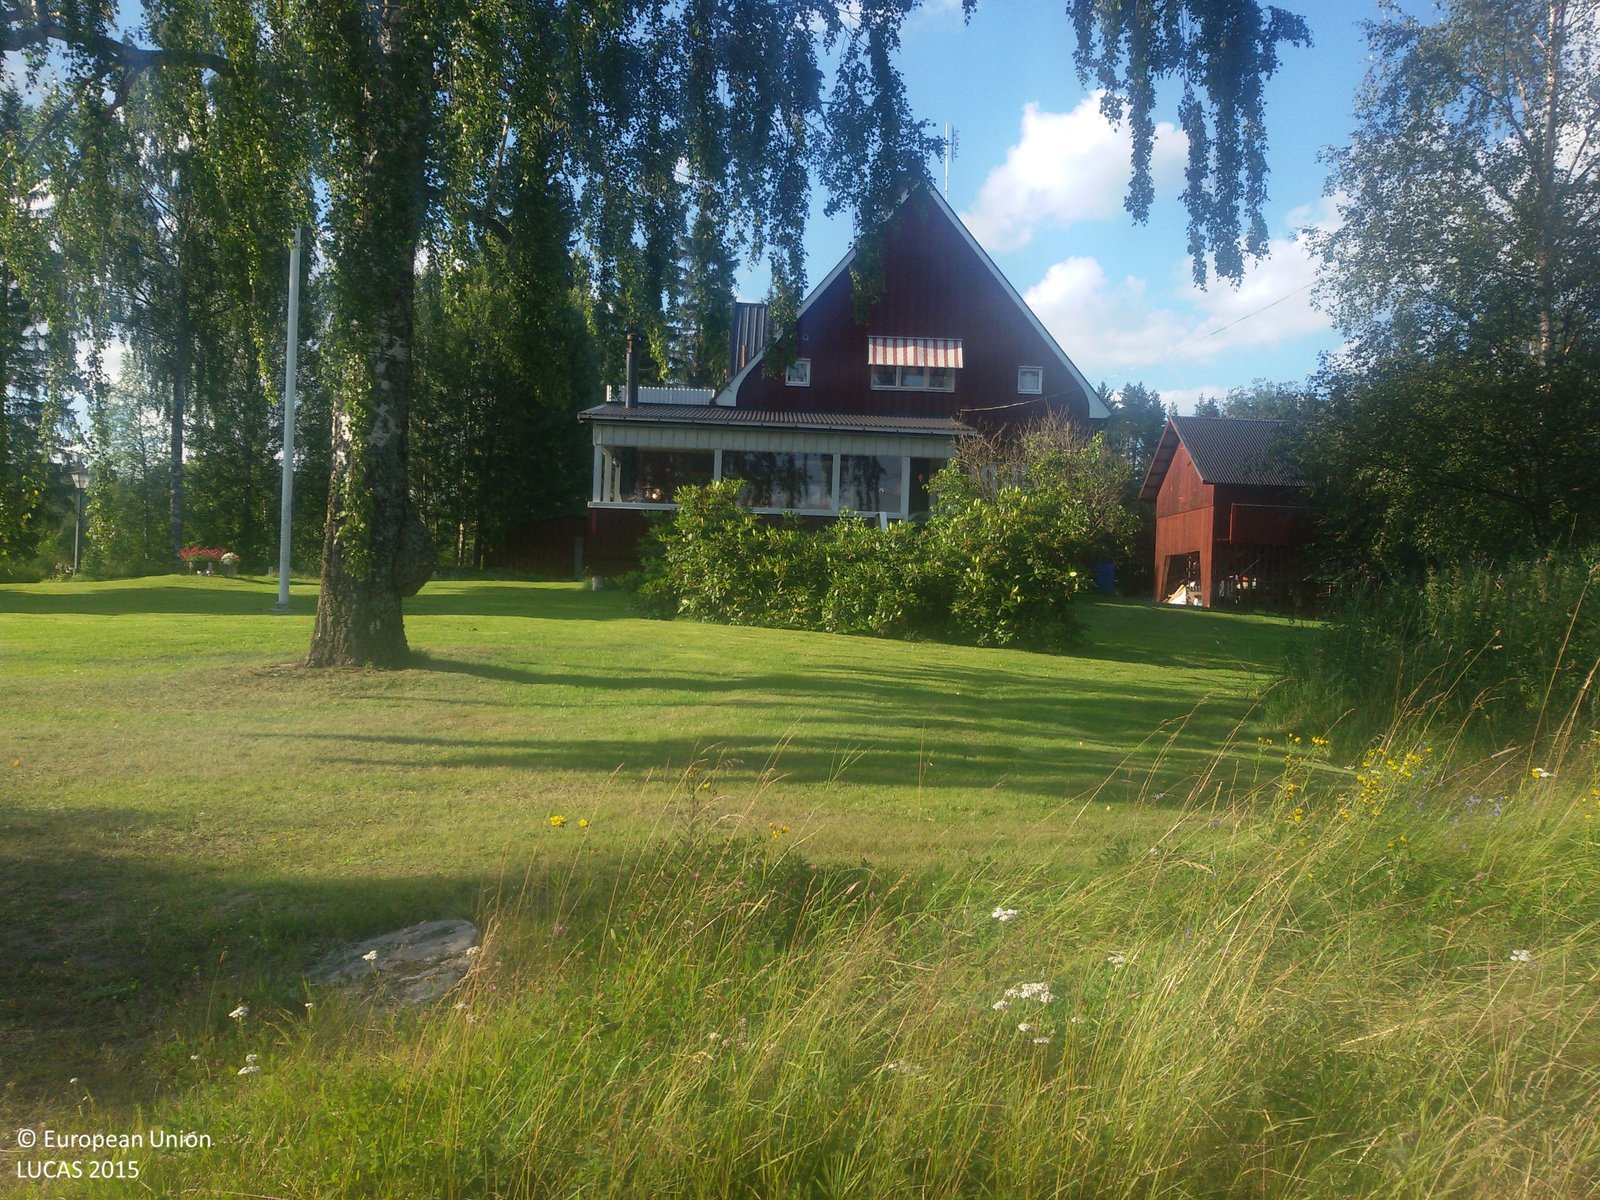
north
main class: Grassland
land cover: Grassland with sparse tree/shrub cover
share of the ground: > 75 %
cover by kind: herbaceous plants 95 %, broadleaved forest trees 5 %
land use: Residential
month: August
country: SE
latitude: 60.6020
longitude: 16.6543
